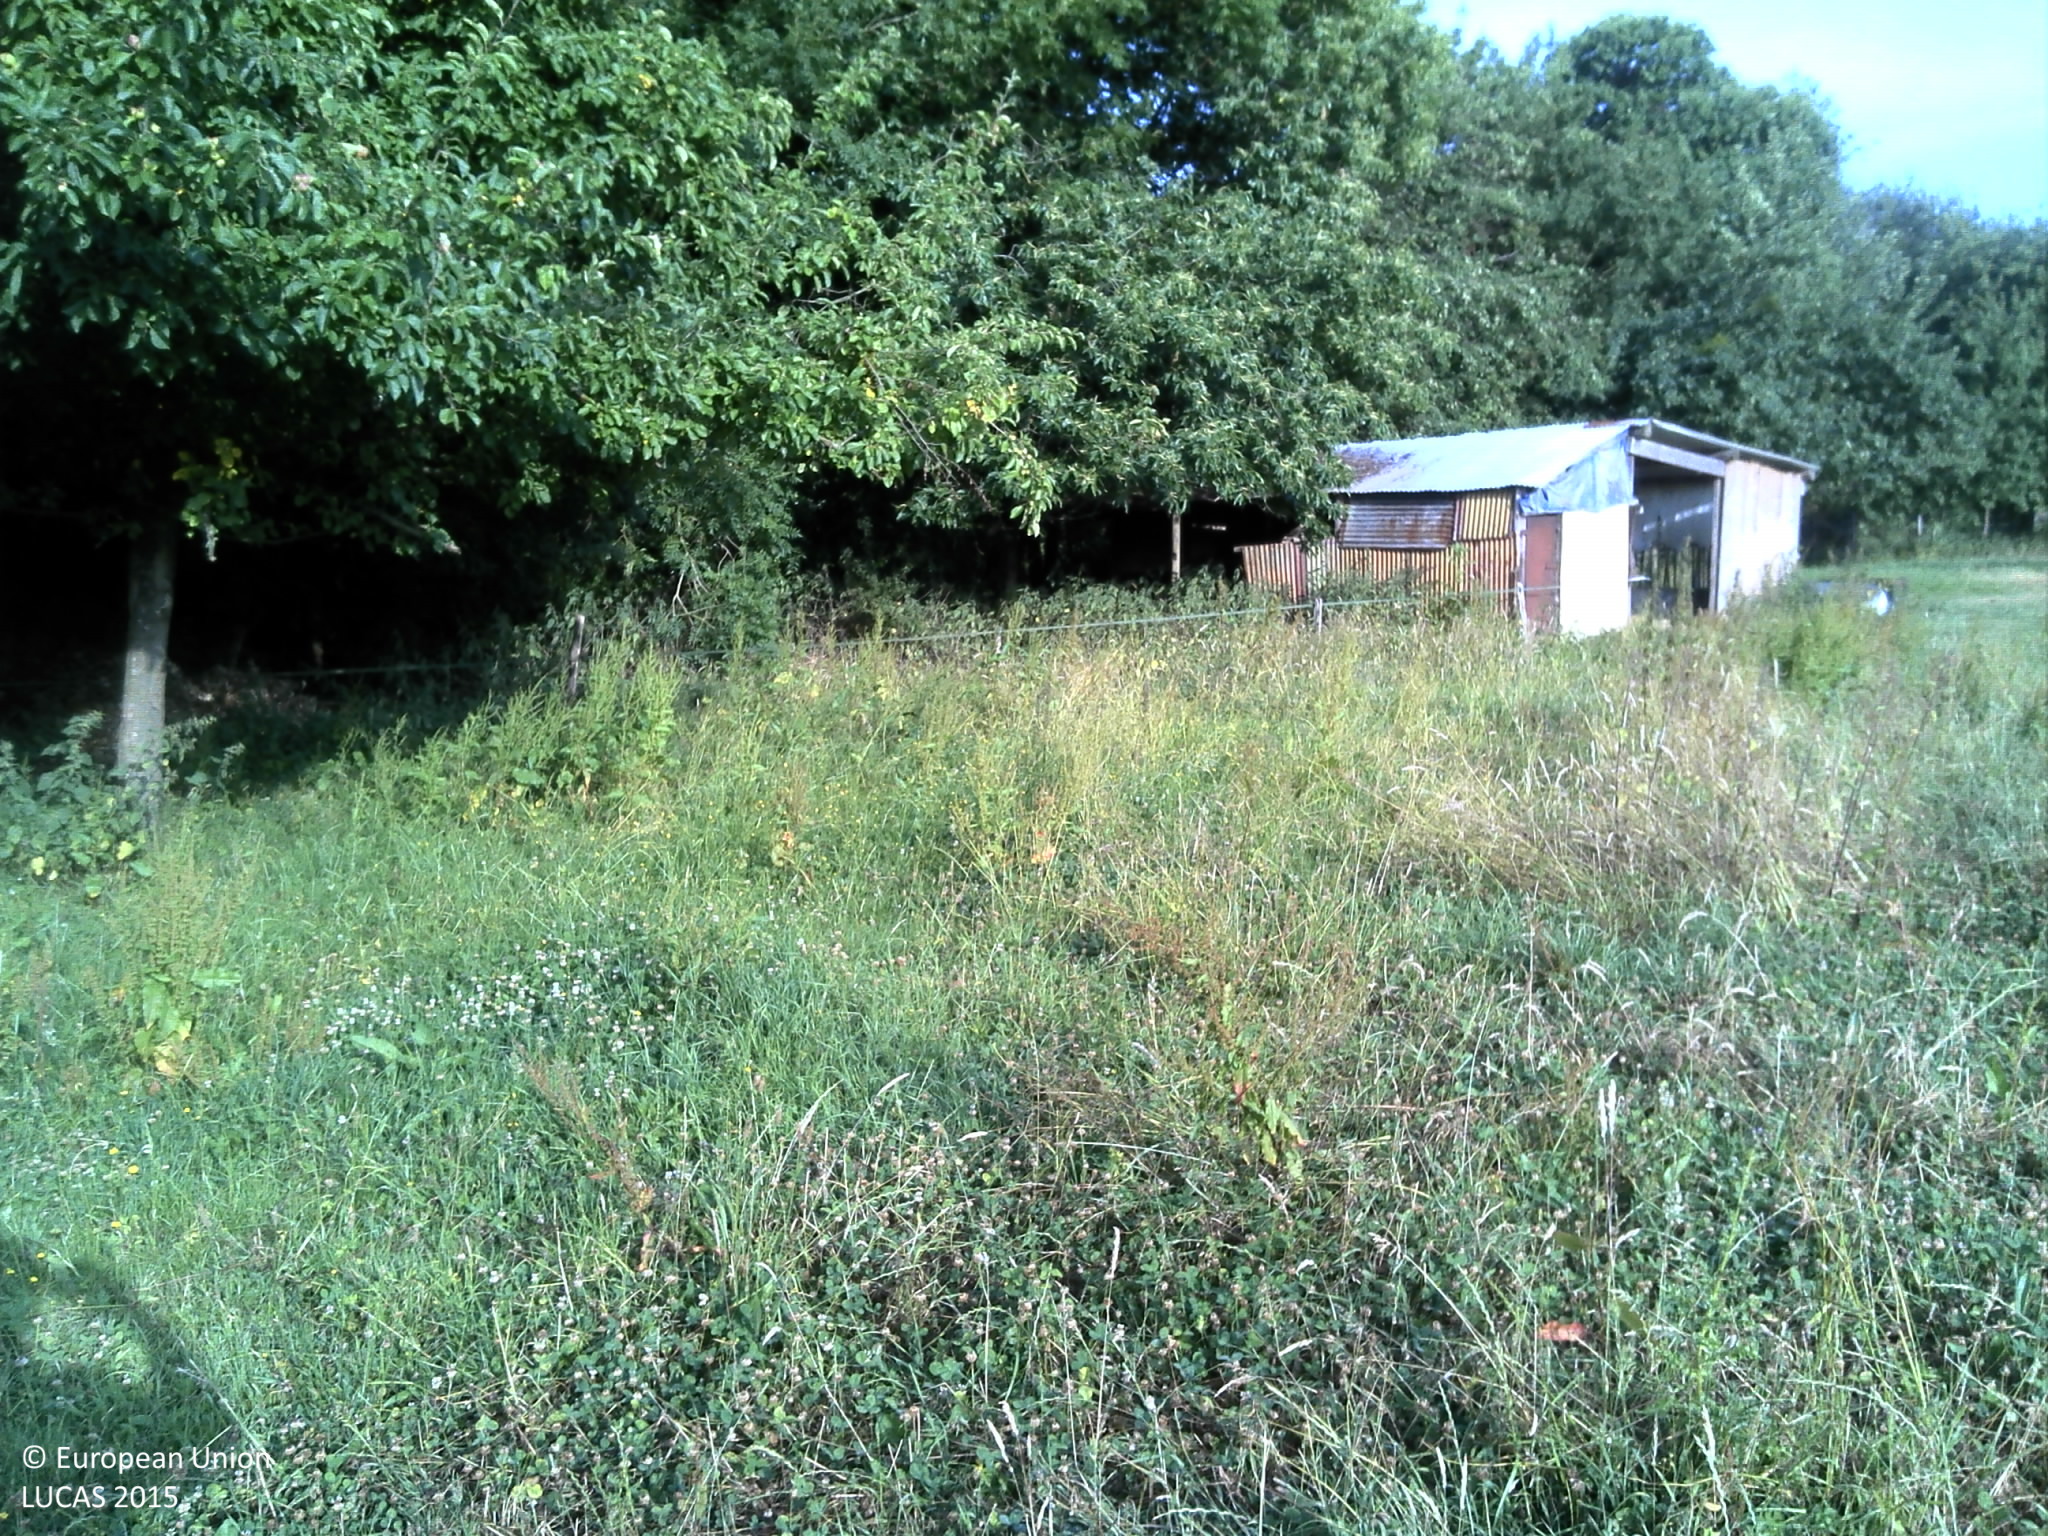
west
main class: Grassland
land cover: Grassland without tree/shrub cover
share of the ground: > 75 %
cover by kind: herbaceous plants 100 %
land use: Agriculture (excluding fallow land and kitchen gardens)
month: July
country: FR
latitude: 49.3693
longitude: 1.1517
